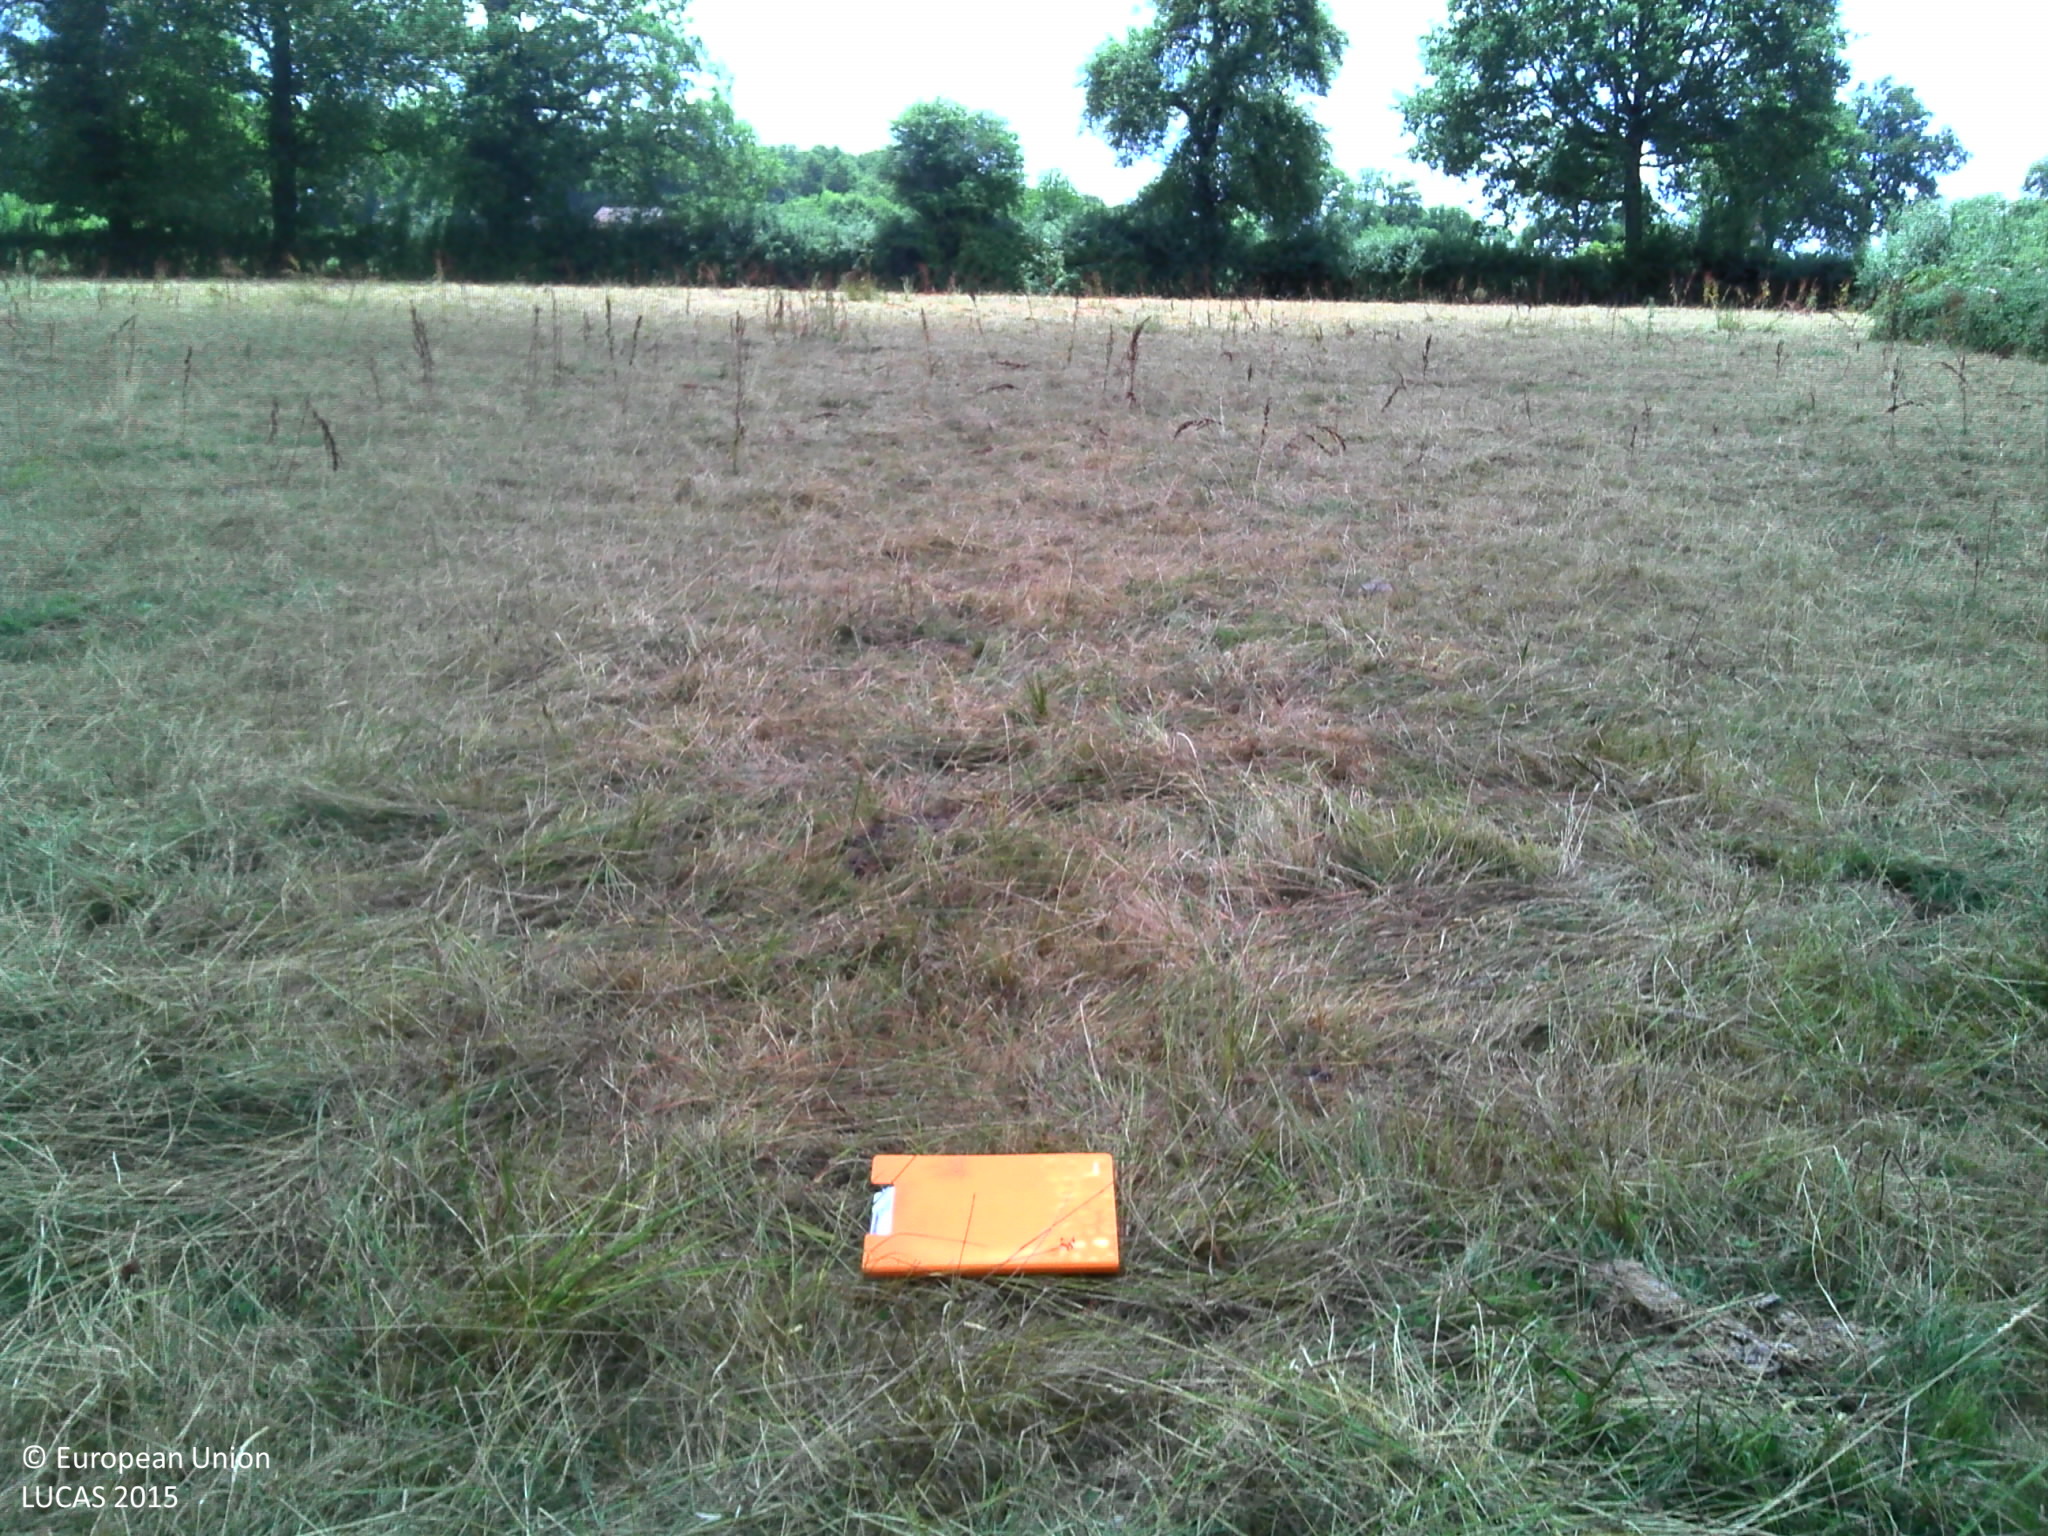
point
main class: Grassland
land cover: Grassland without tree/shrub cover
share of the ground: > 75 %
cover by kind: herbaceous plants 100 %
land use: Agriculture (excluding fallow land and kitchen gardens)
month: July
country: FR
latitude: 46.4834
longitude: 2.2171
